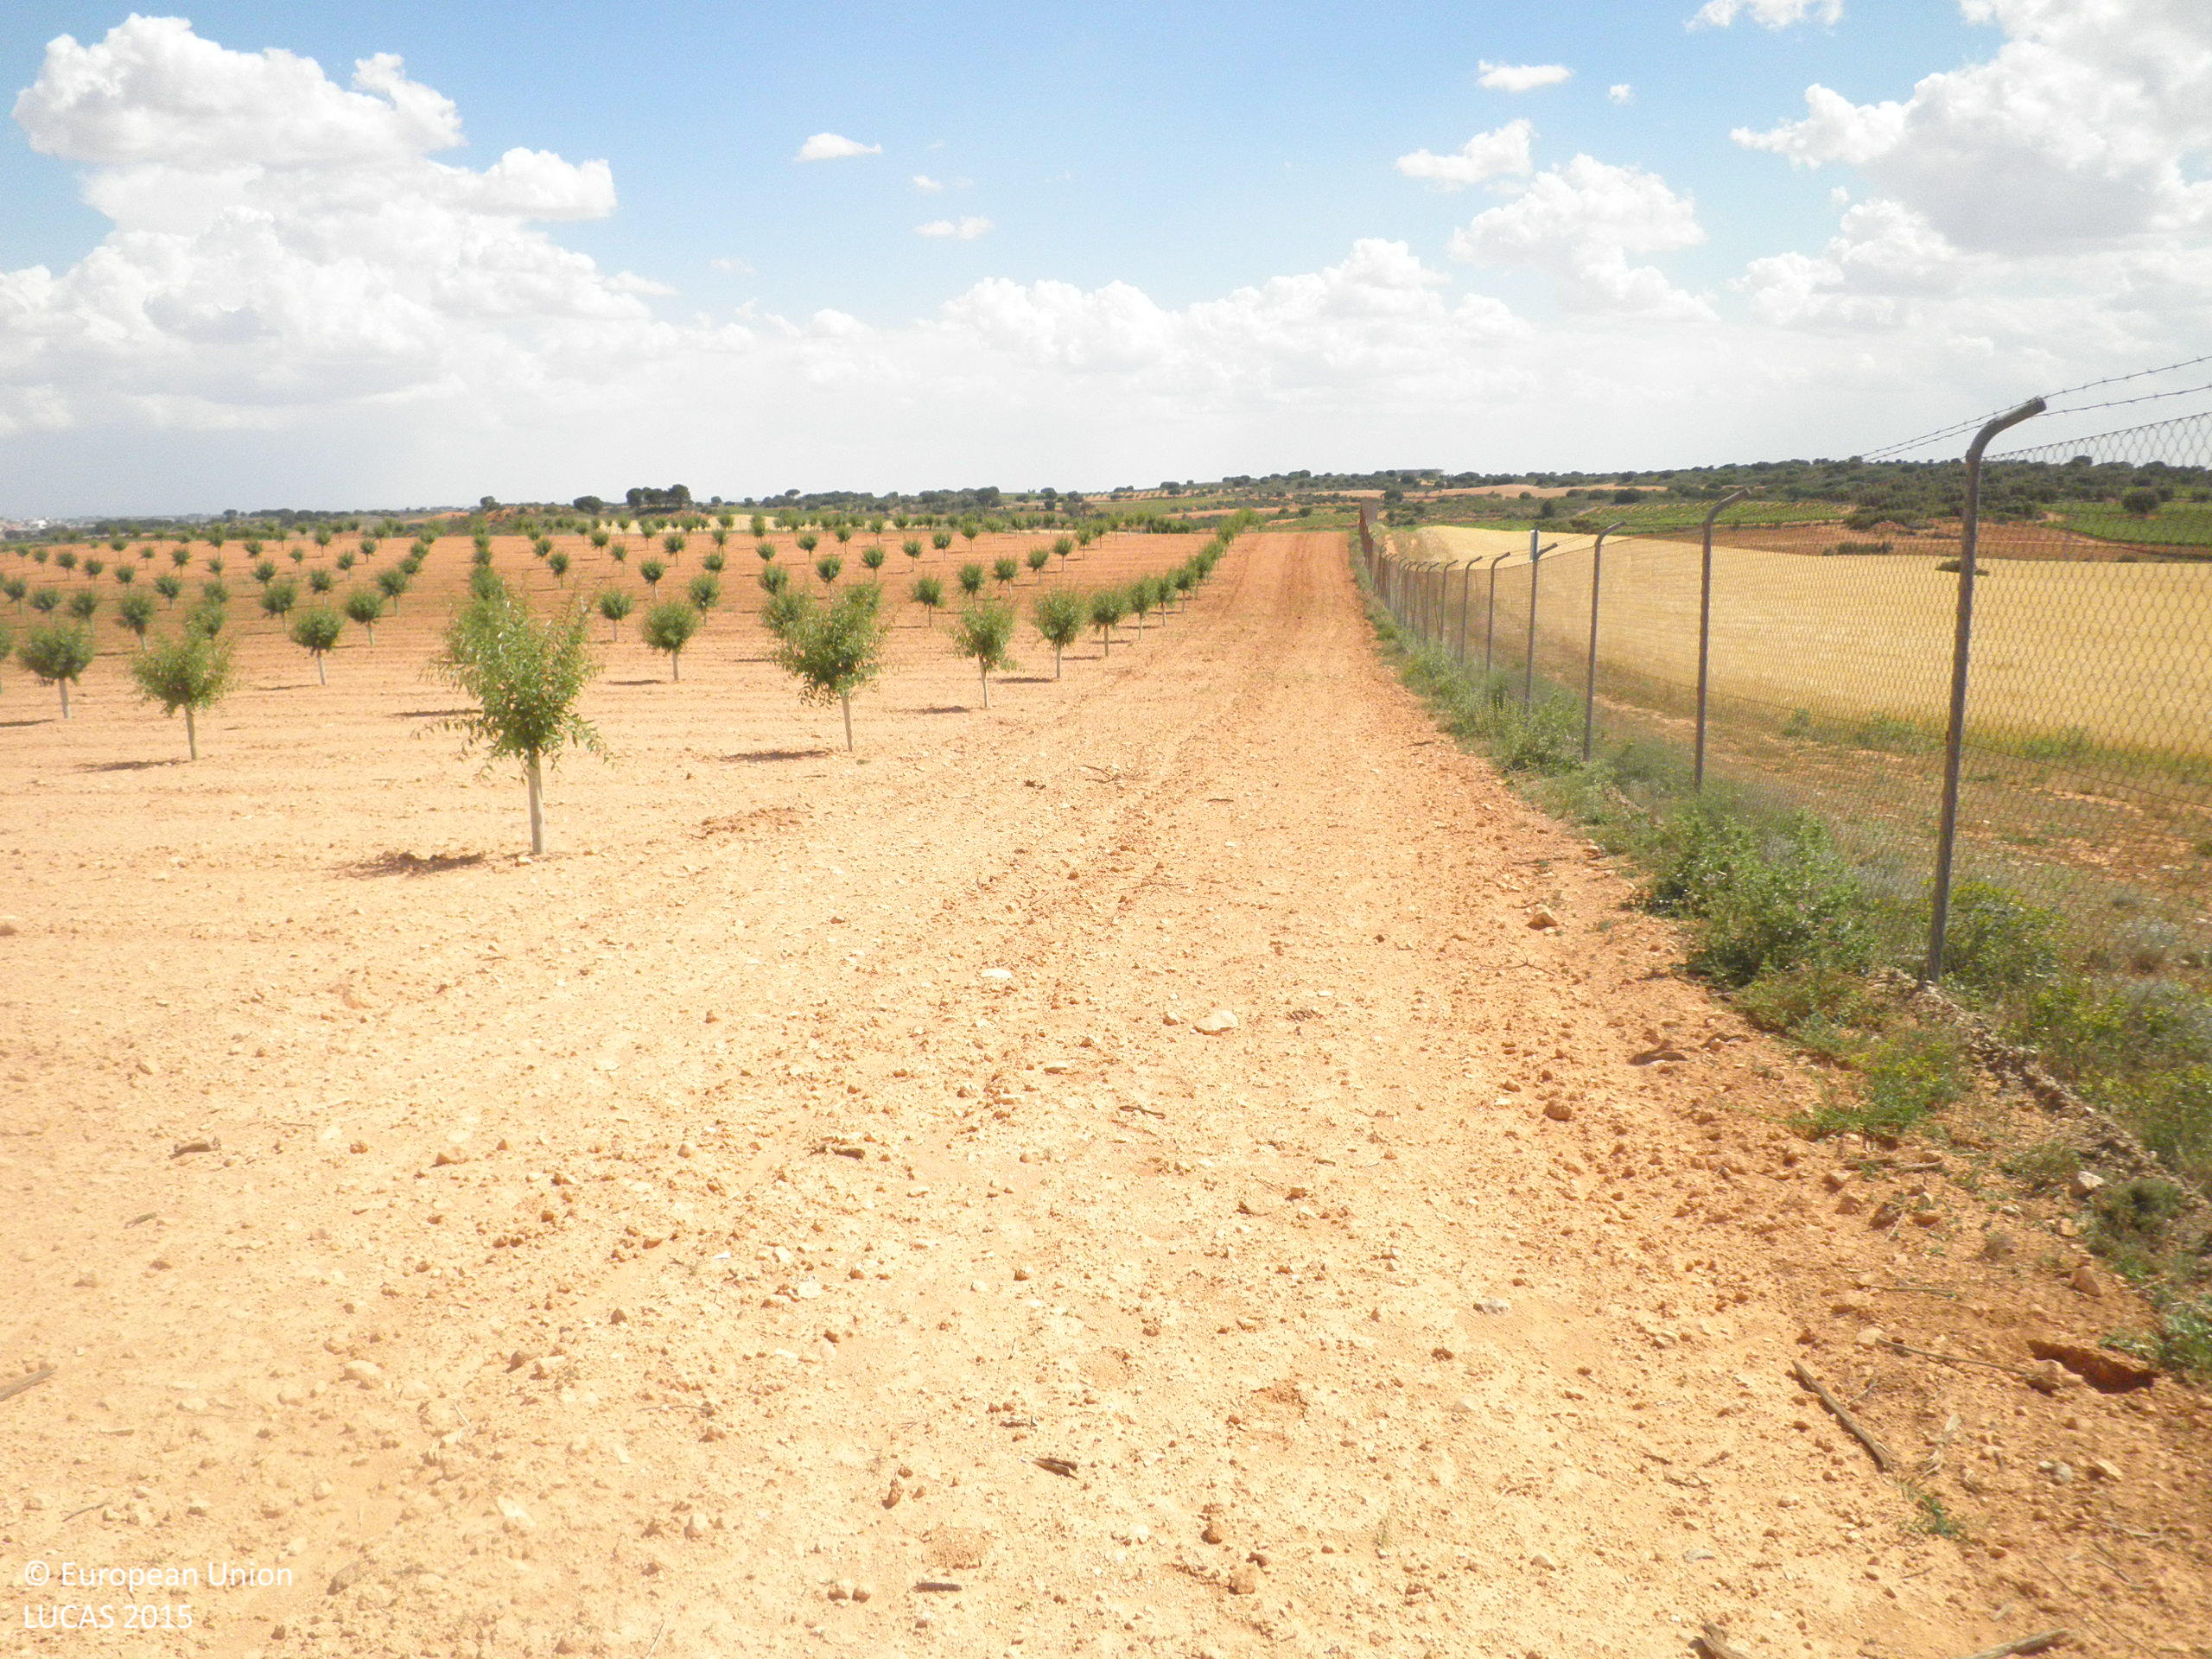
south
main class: Cropland
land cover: Nuts trees
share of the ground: < 10 %
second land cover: Other bare soil
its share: > 75 %
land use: Agriculture (excluding fallow land and kitchen gardens)
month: June
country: ES
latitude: 39.4816
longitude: -1.7829
